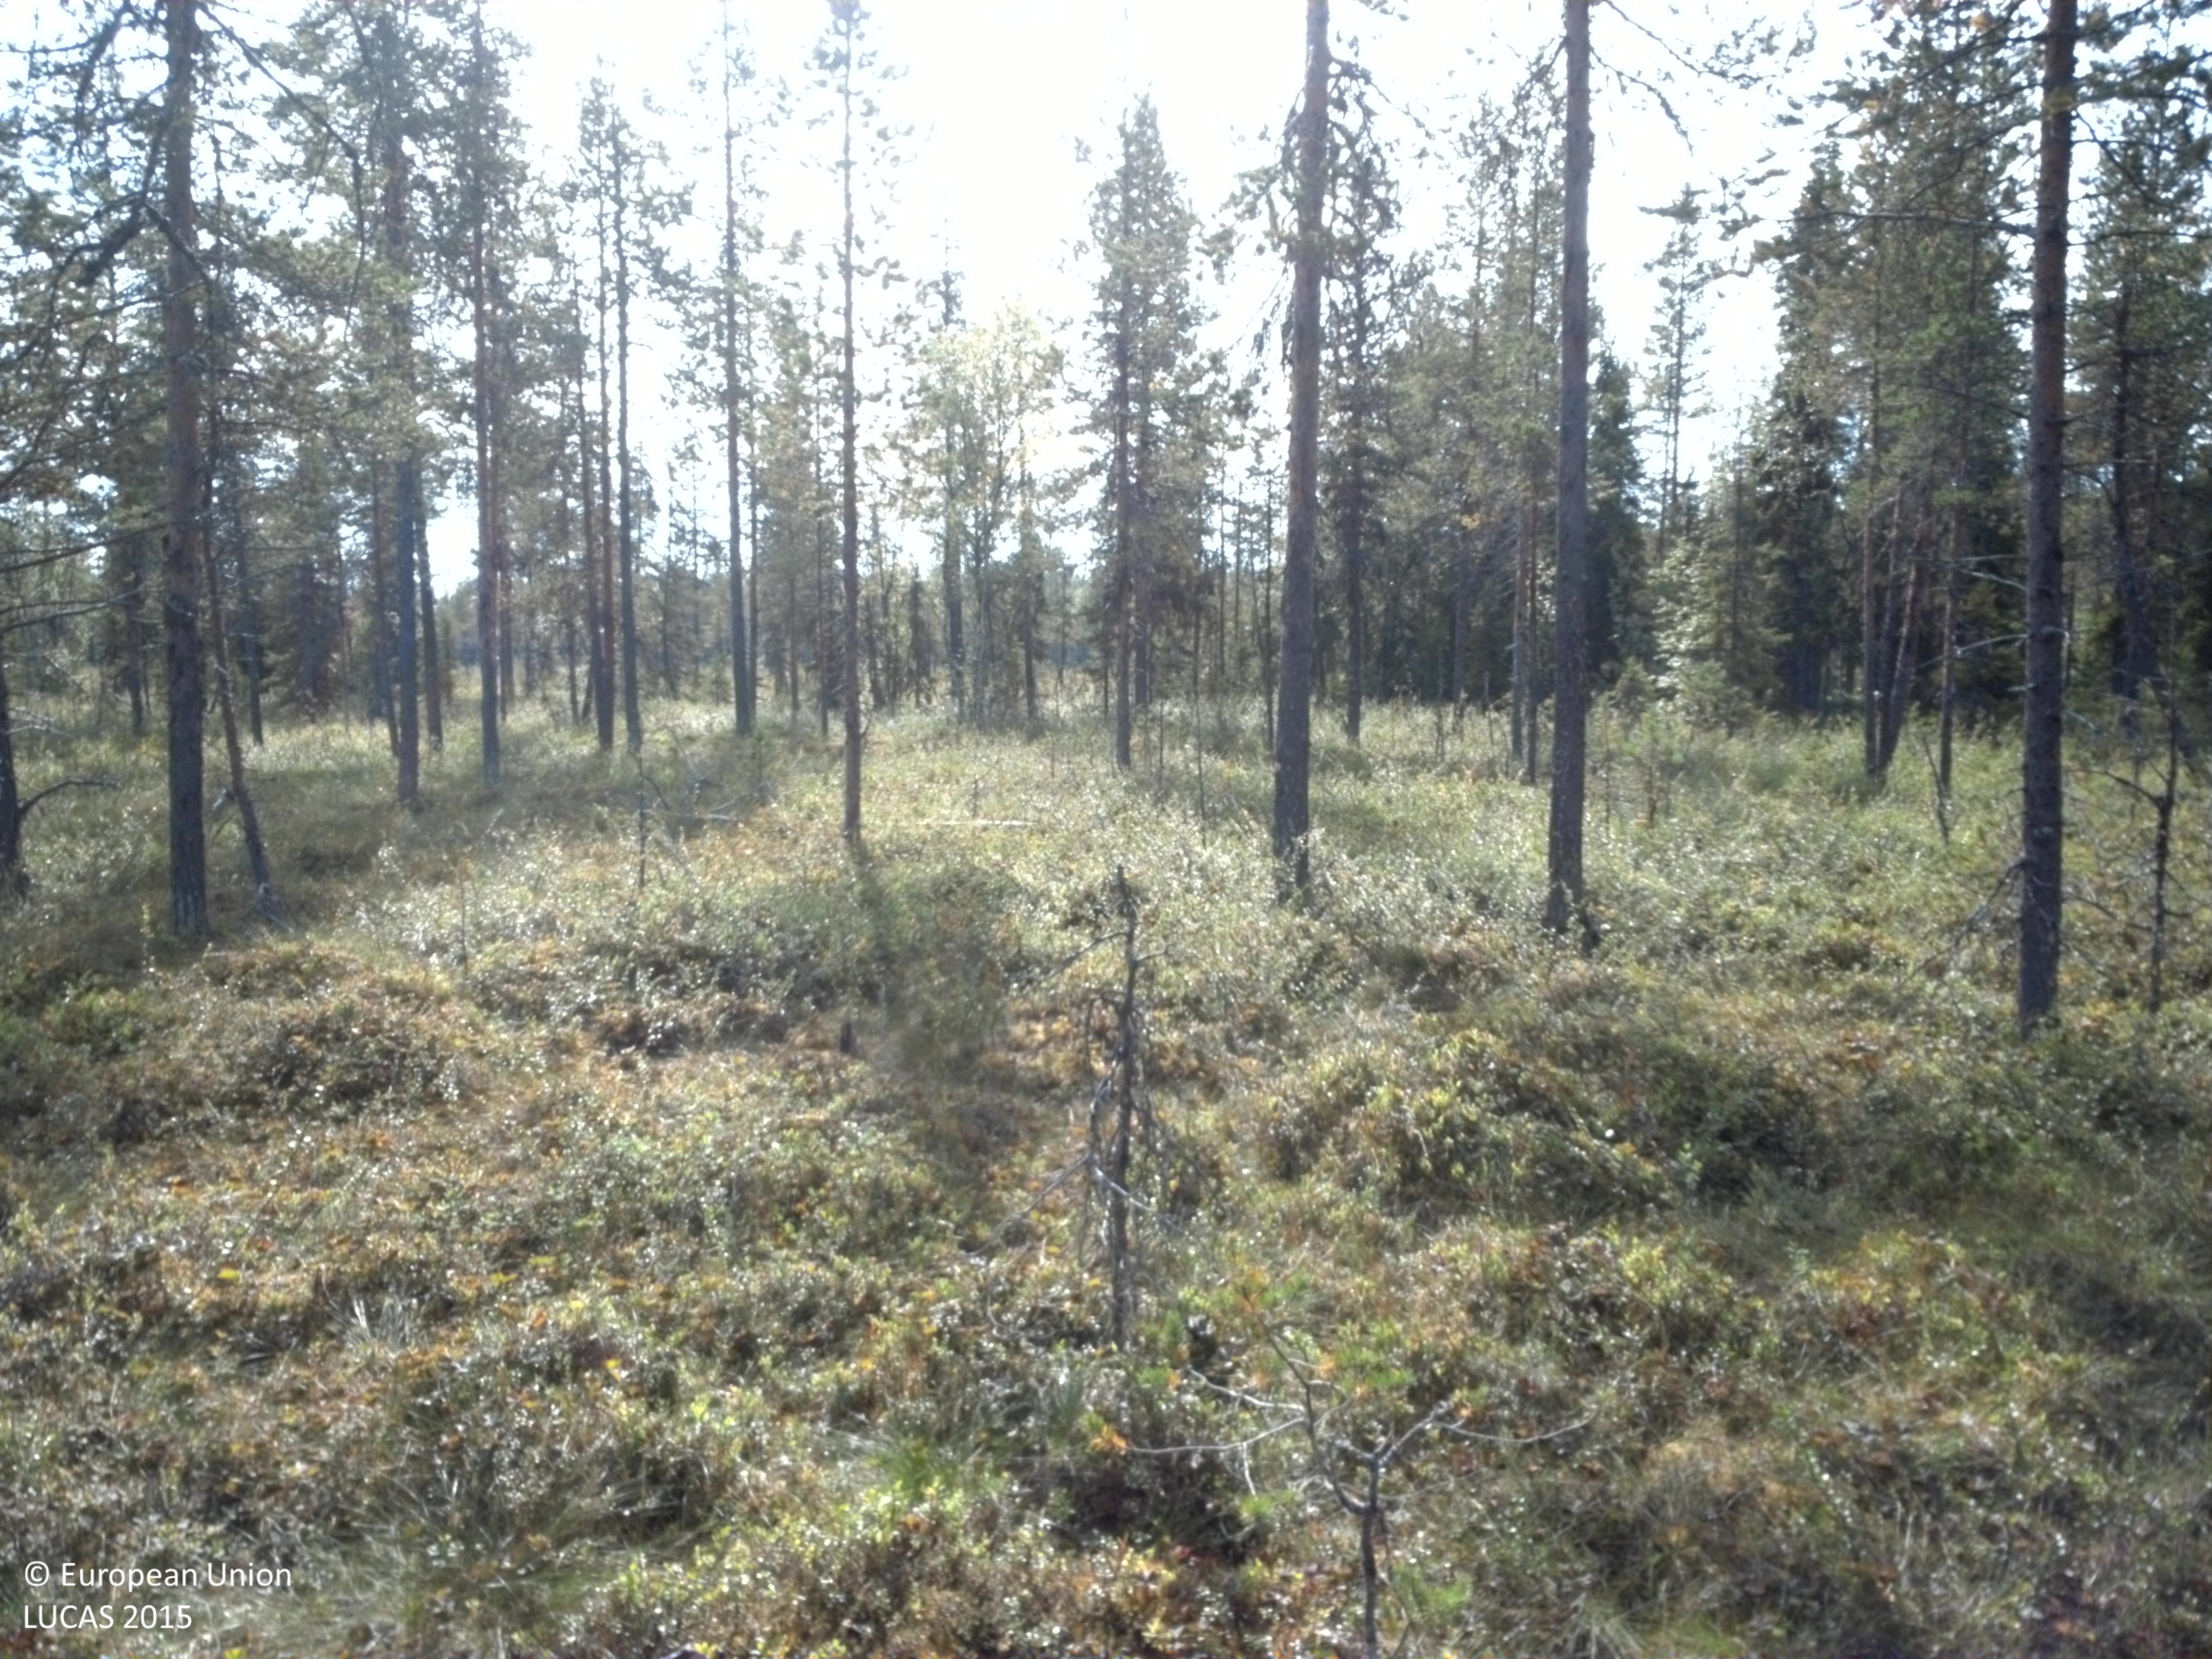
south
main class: Woodland
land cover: Pine dominated coniferous woodland
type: boreal forest
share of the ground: 10 - 25 %
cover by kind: shrubs 65 %, coniferous forest trees 20 %, lichens and mosses 10 %, herbaceous plants 5 %
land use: Forestry
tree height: > 5 m
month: August
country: SE
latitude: 64.7022
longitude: 16.4475
